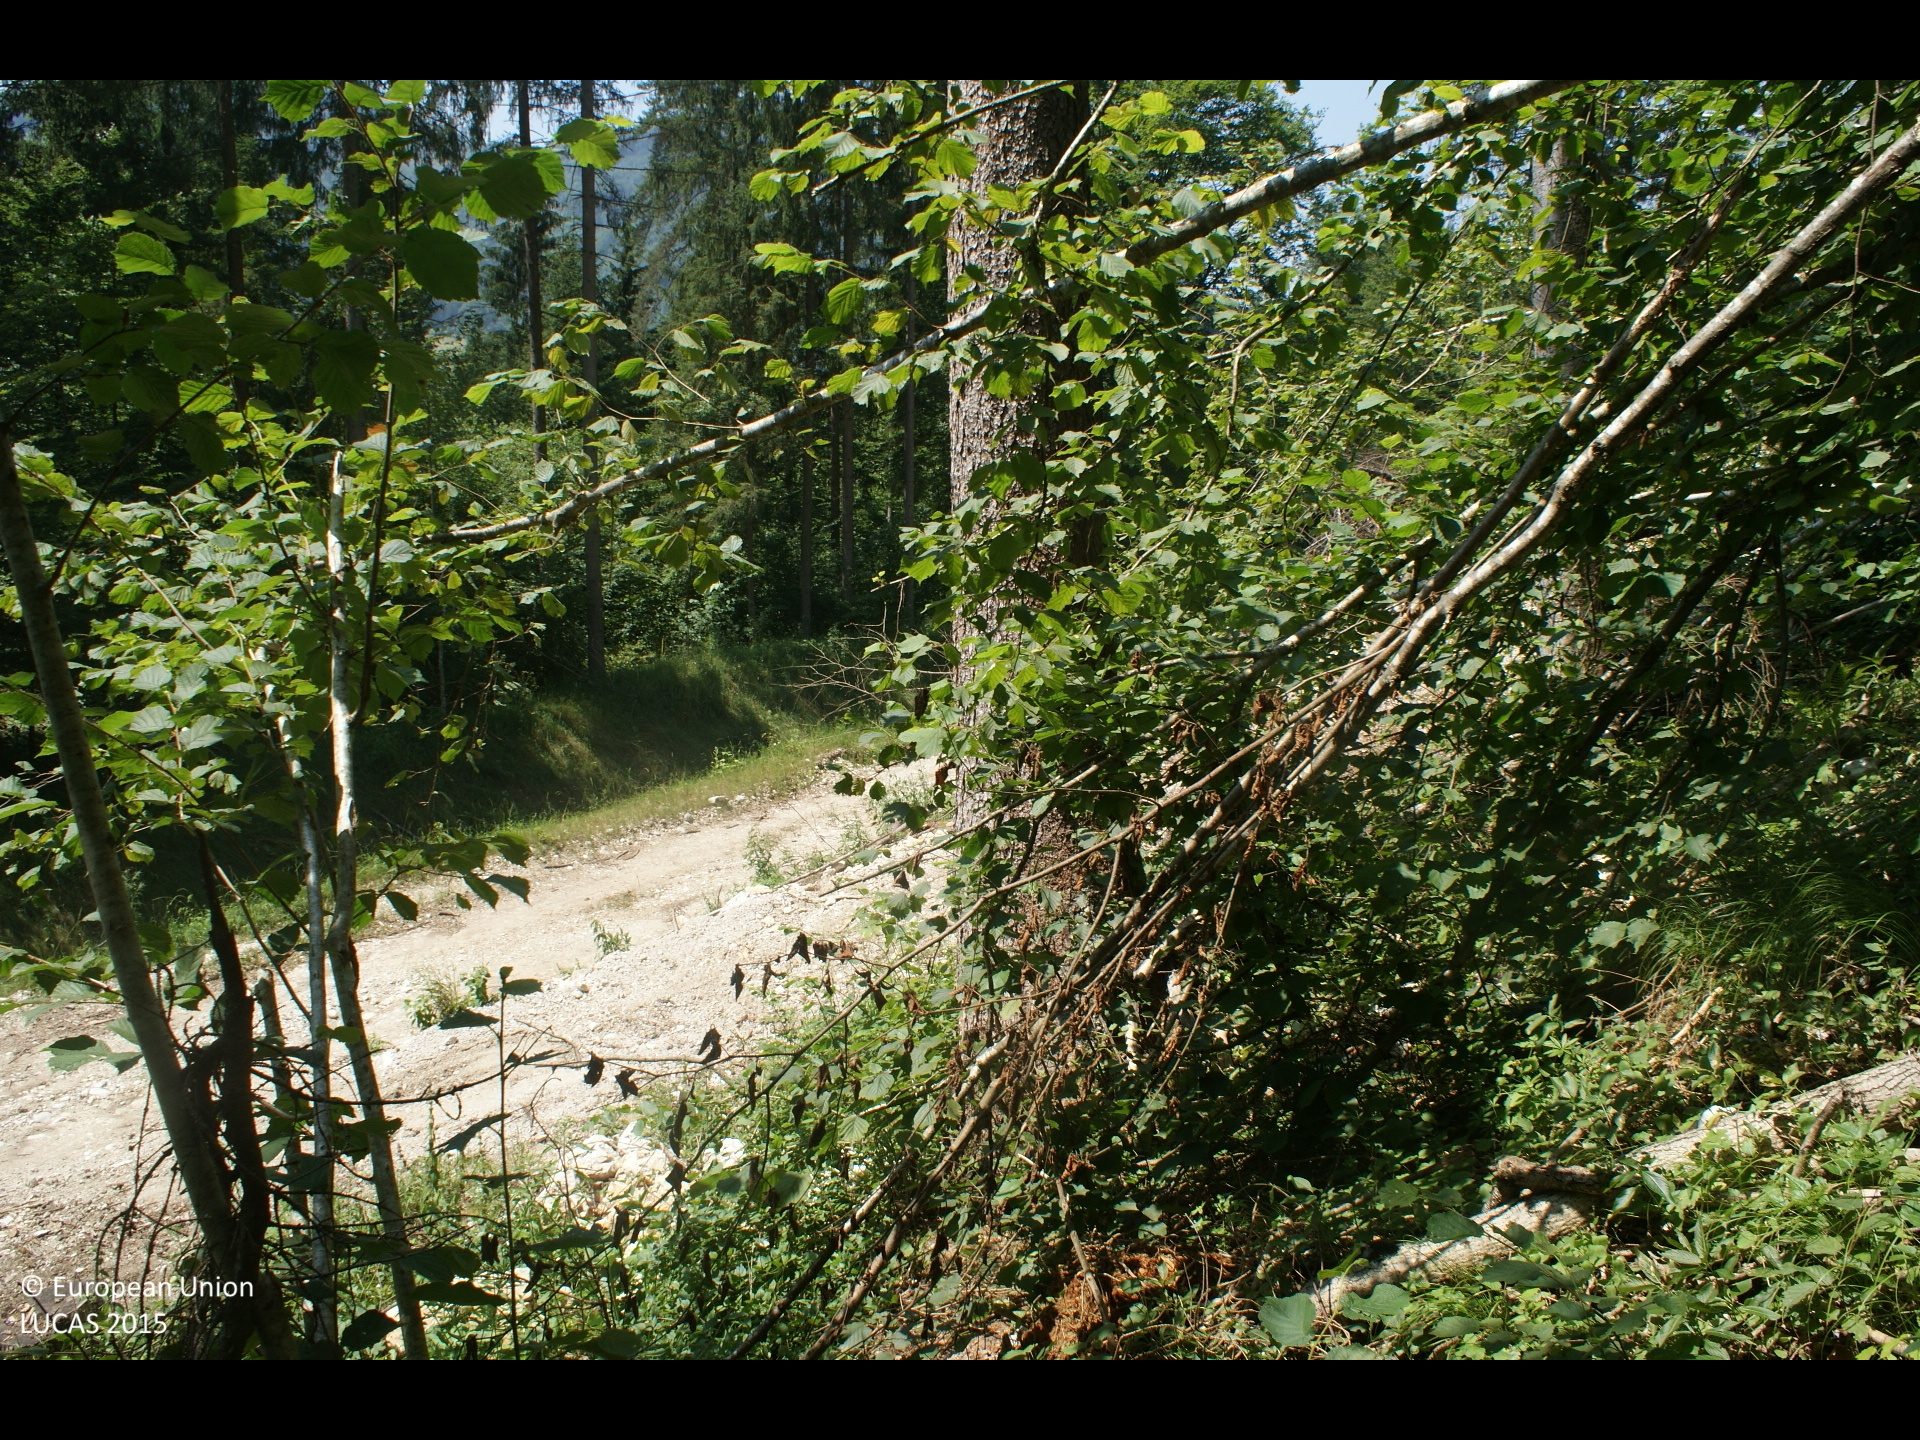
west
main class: Woodland
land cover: Other mixed woodland
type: mesophytic deciduous forest
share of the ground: > 75 %
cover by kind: broadleaved forest trees 50 %, coniferous forest trees 30 %, shrubs 20 %
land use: Forestry
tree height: > 5 m
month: July
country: AT
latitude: 47.9077
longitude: 14.2406
